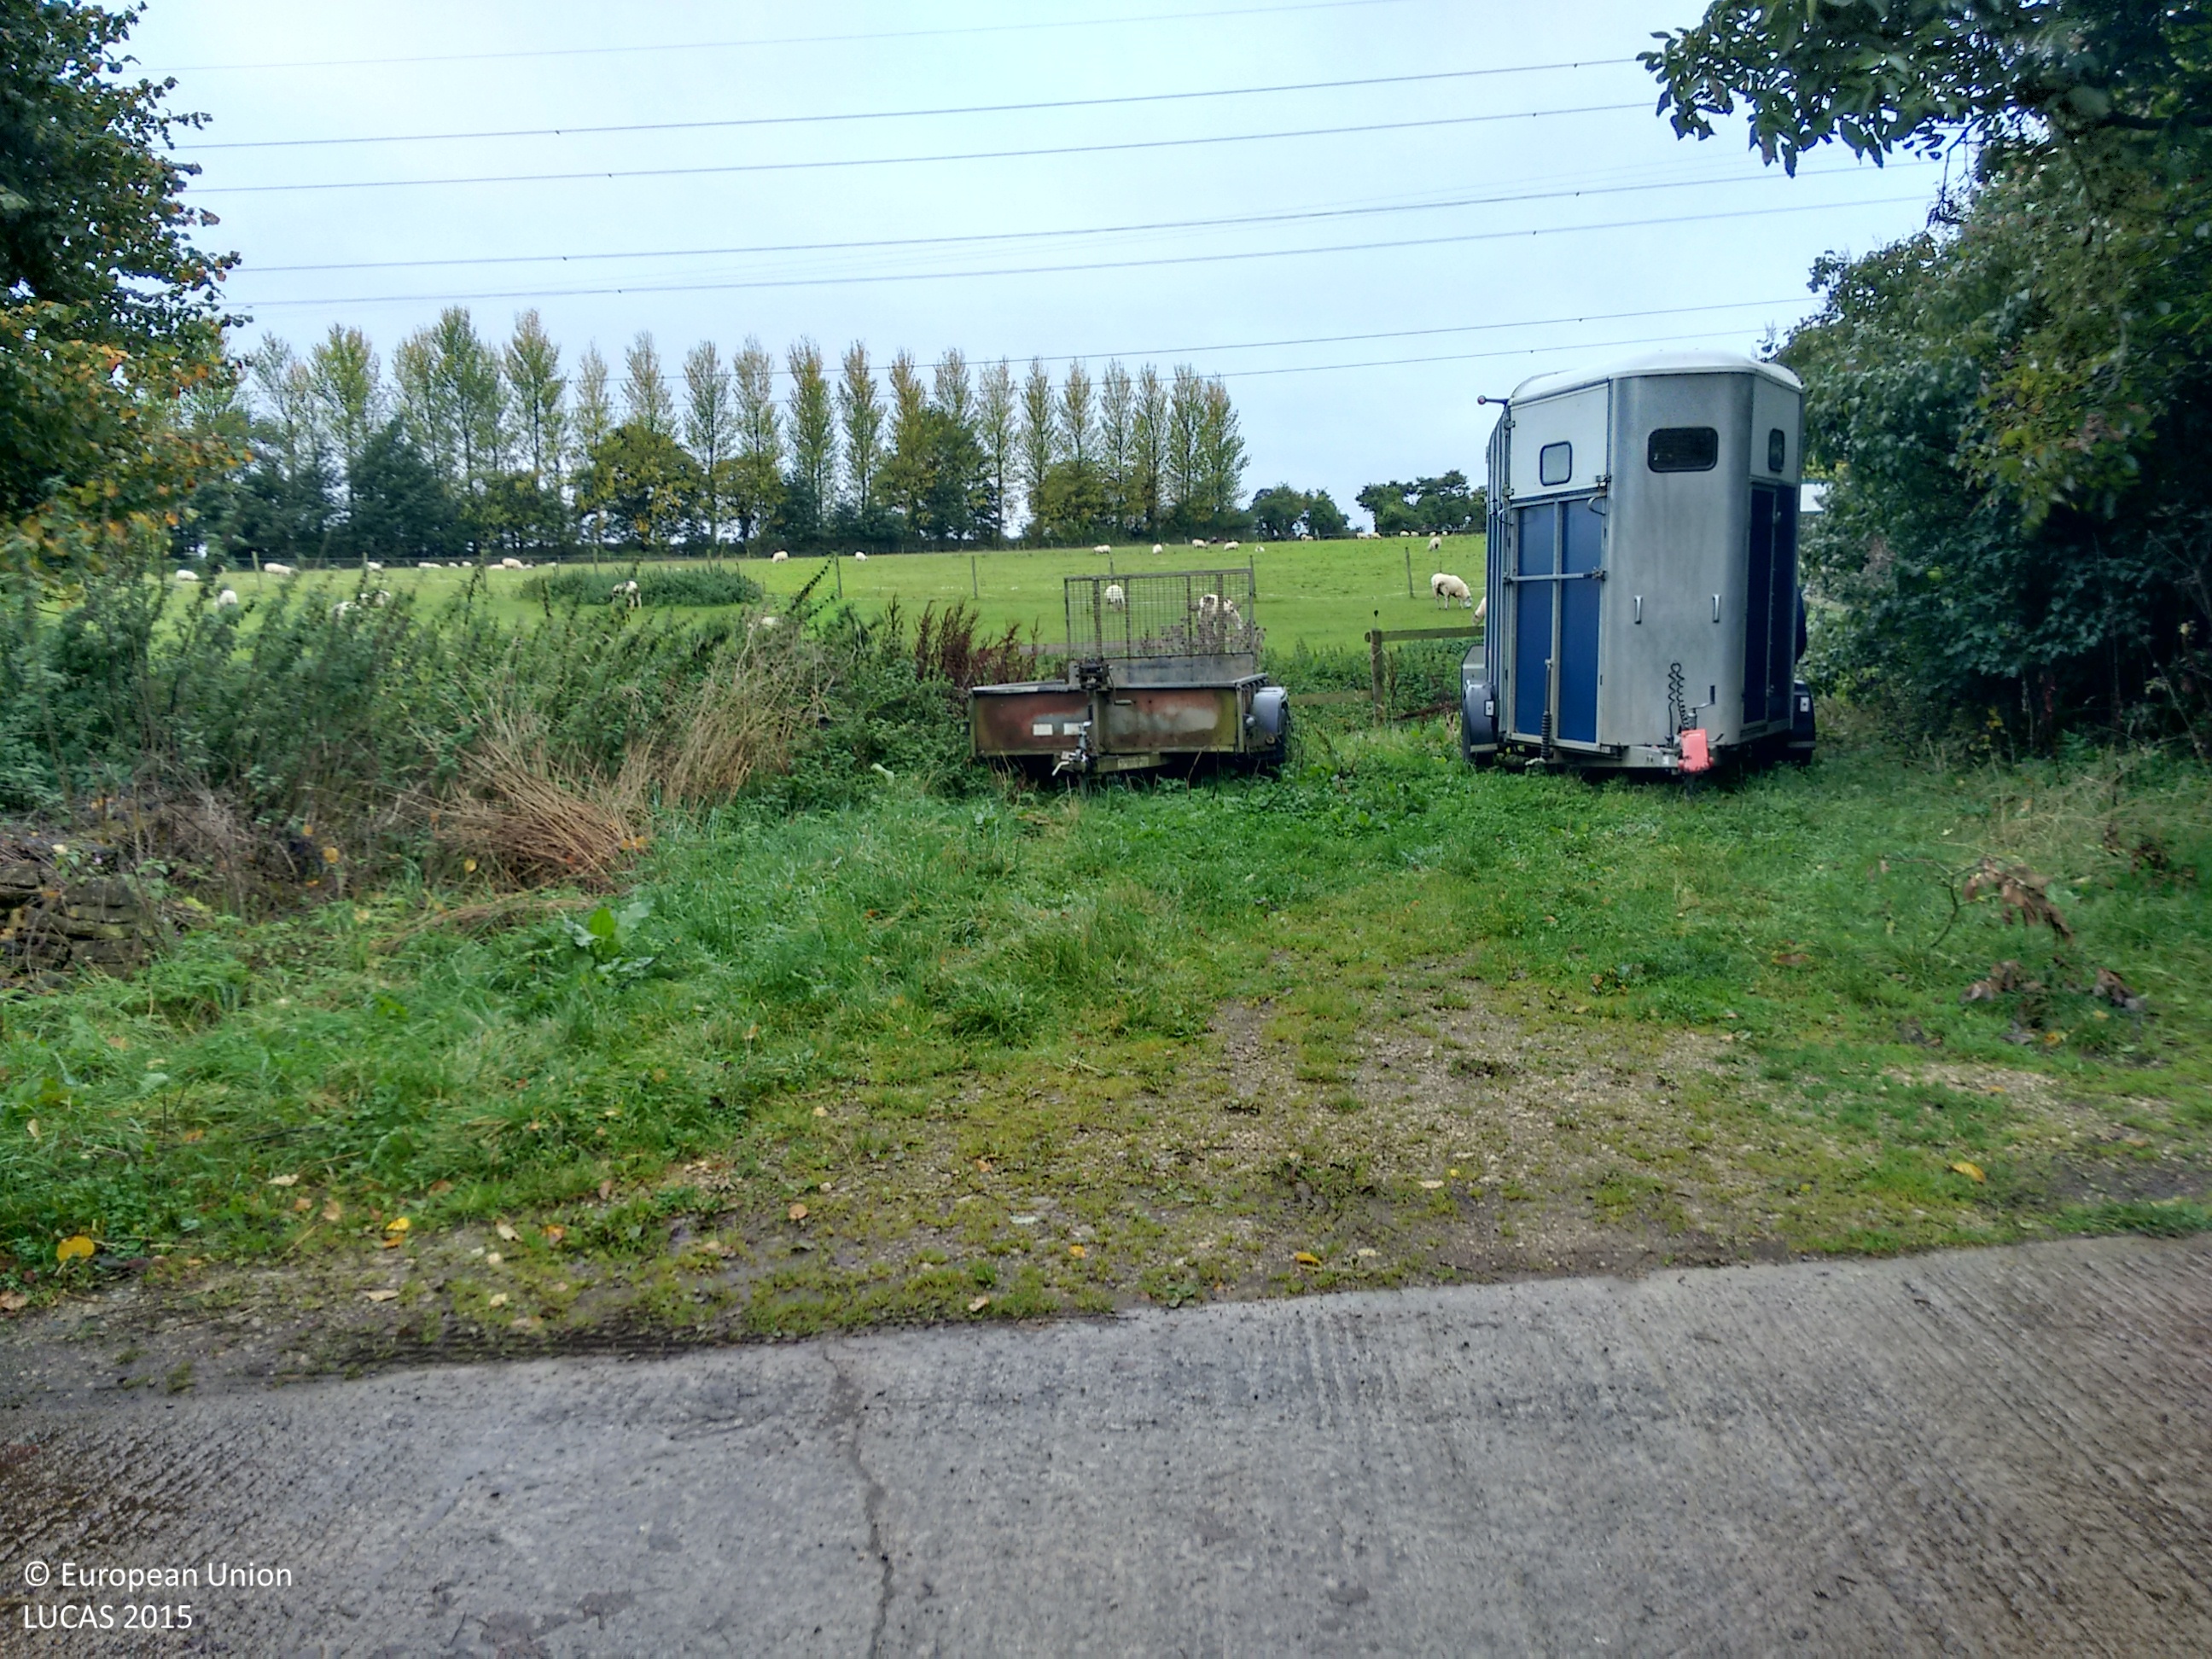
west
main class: Grassland
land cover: Grassland with sparse tree/shrub cover
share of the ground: > 75 %
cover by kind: herbaceous plants 90 %, broadleaved forest trees 5 %, shrubs 5 %
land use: Residential
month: October
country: GB
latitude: 51.7677
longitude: -1.9842
